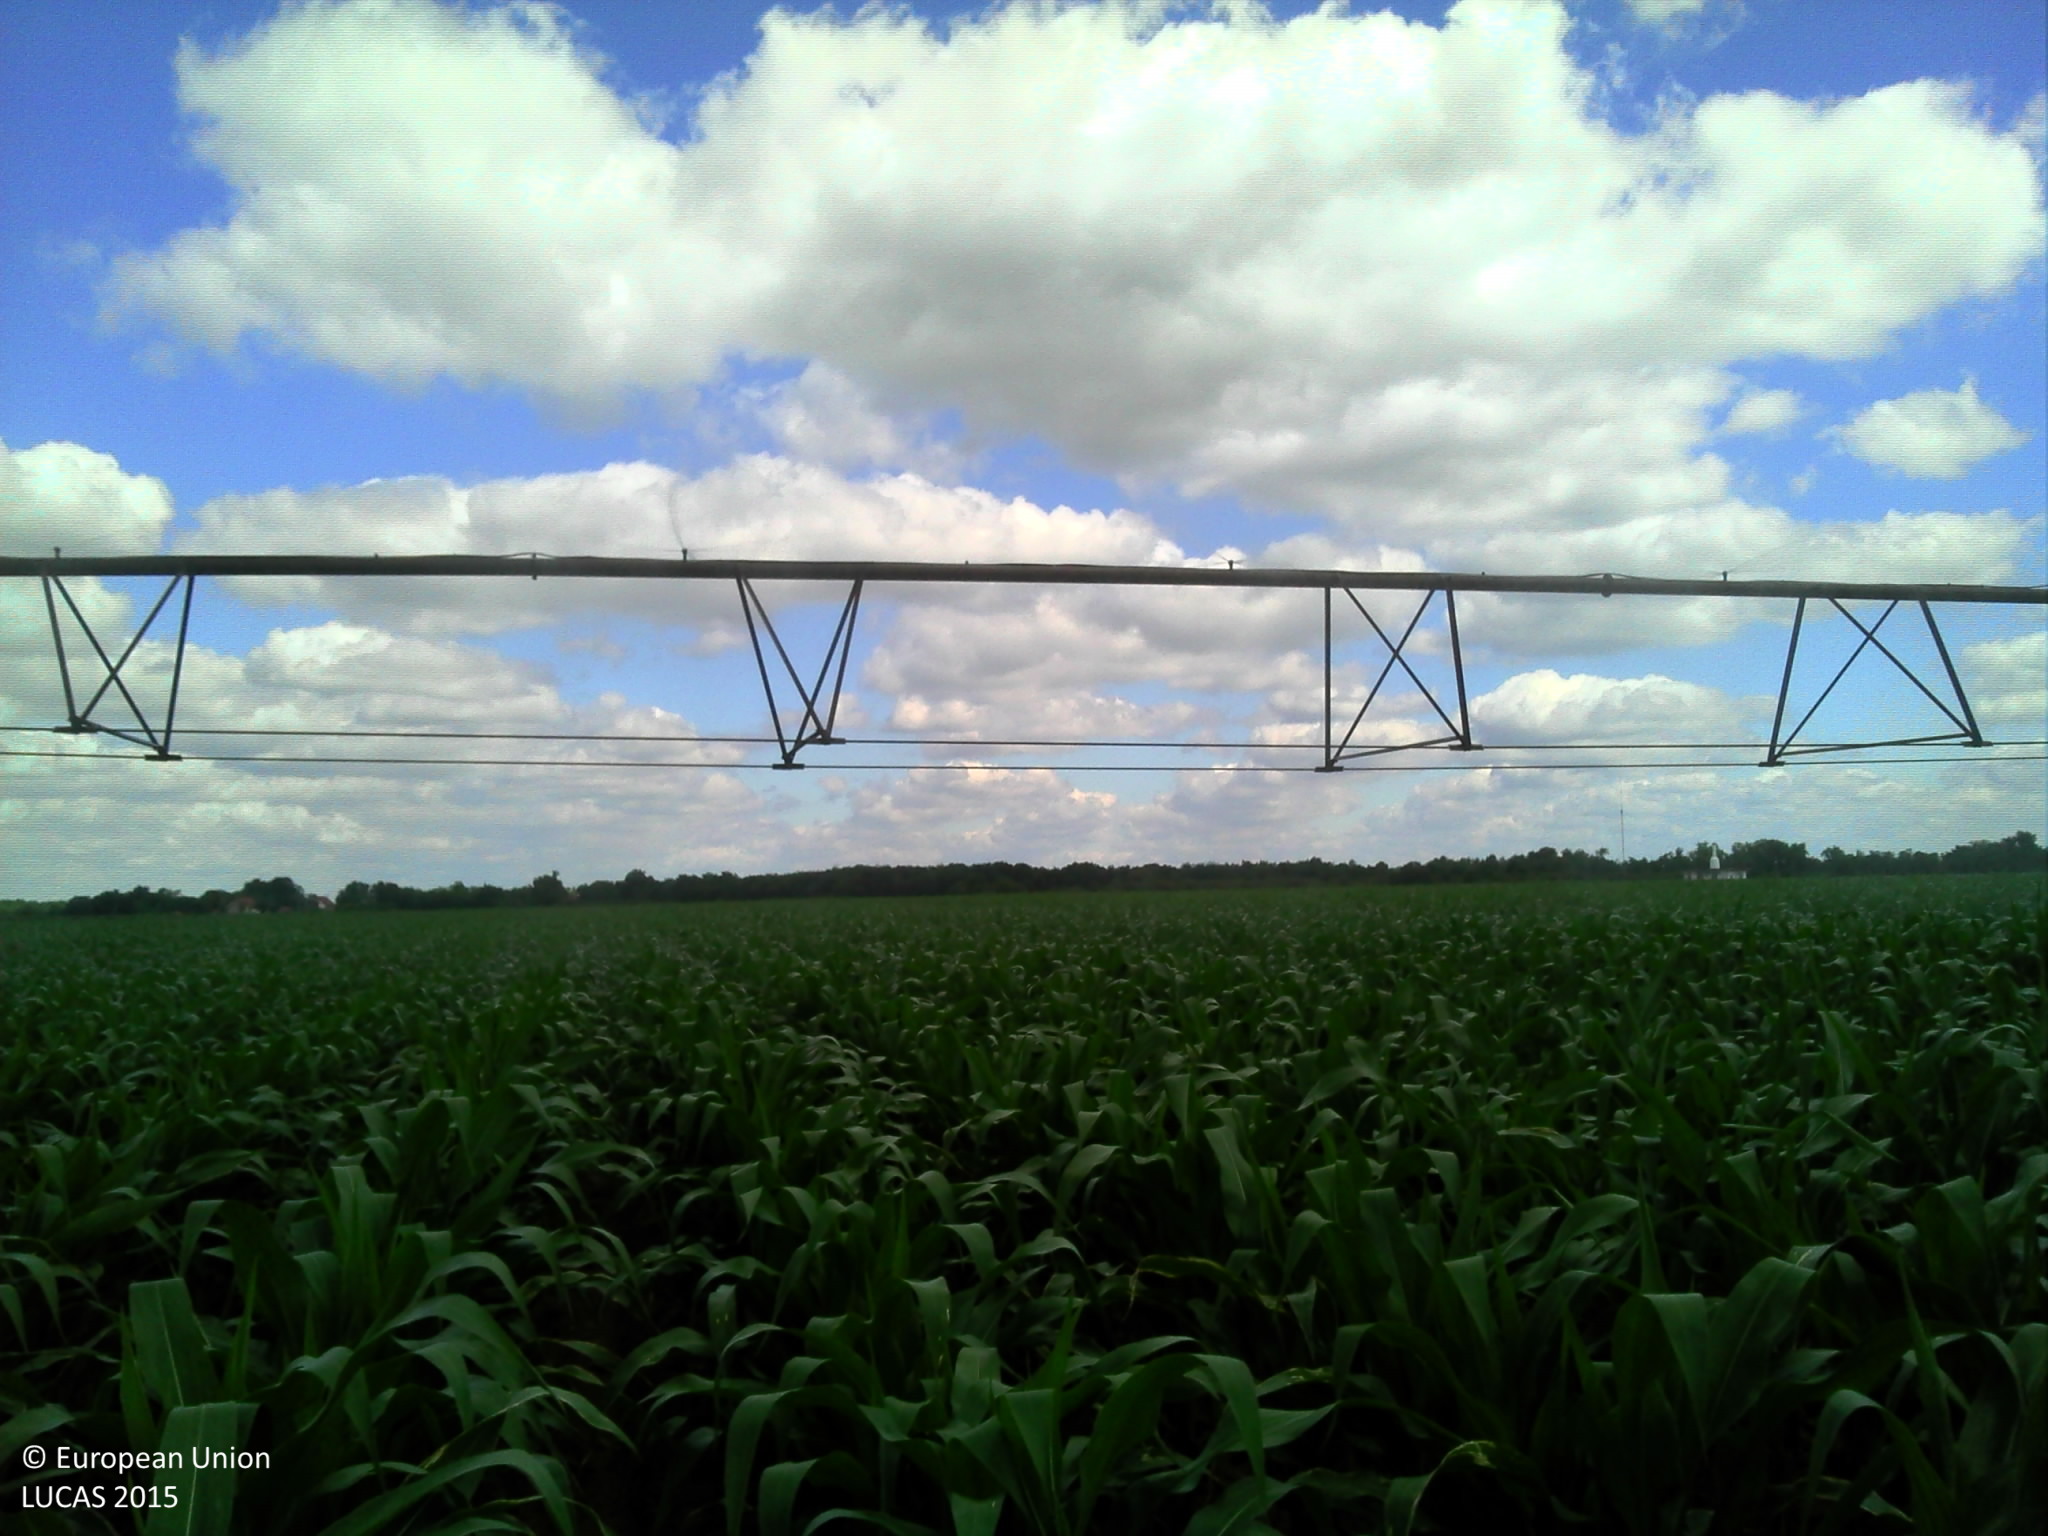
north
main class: Cropland
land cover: Maize
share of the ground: > 75 %
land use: Agriculture (excluding fallow land and kitchen gardens)
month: June
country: FR
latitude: 46.7032
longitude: 3.6292
